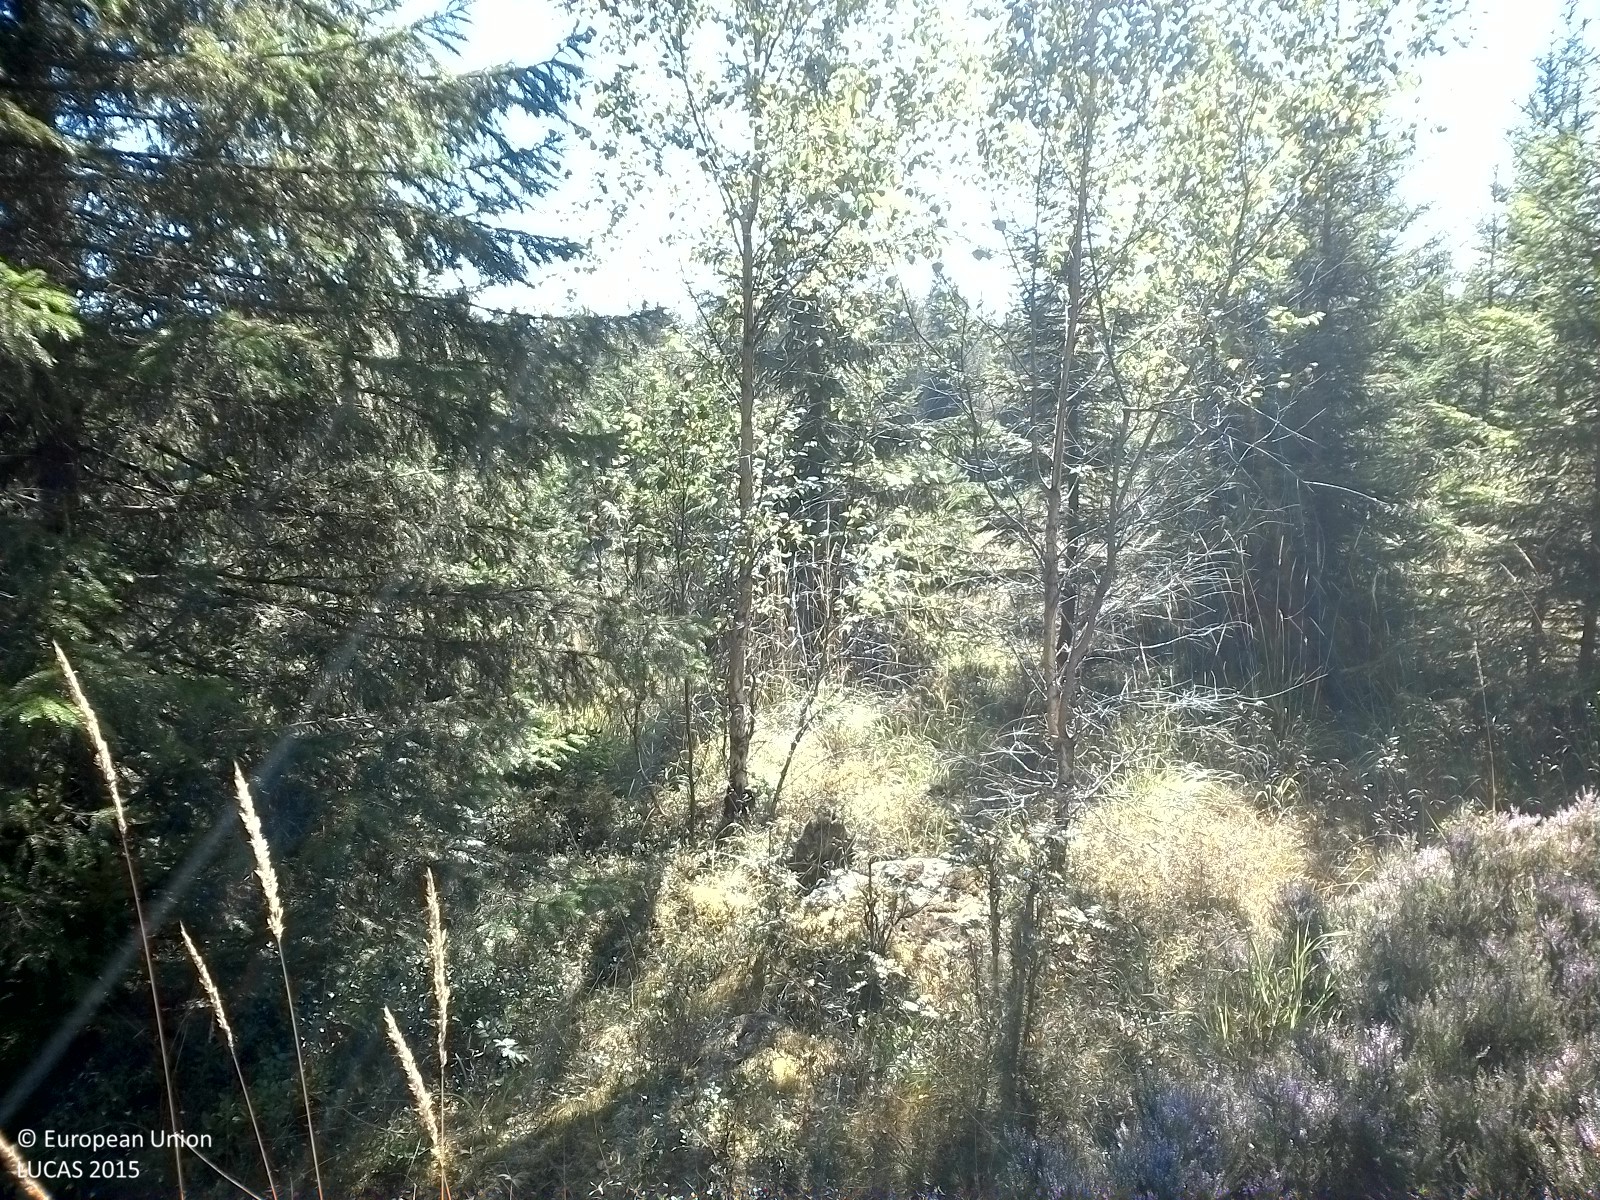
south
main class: Woodland
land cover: Spruce dominated mixed woodland
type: boreal forest
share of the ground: 25 - 50 %
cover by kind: herbaceous plants 30 %, shrubs 25 %, coniferous forest trees 20 %, broadleaved forest trees 15 %, lichens and mosses 10 %
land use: Forestry
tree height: < 5 m
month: August
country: SE
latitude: 59.4037
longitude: 15.0817
